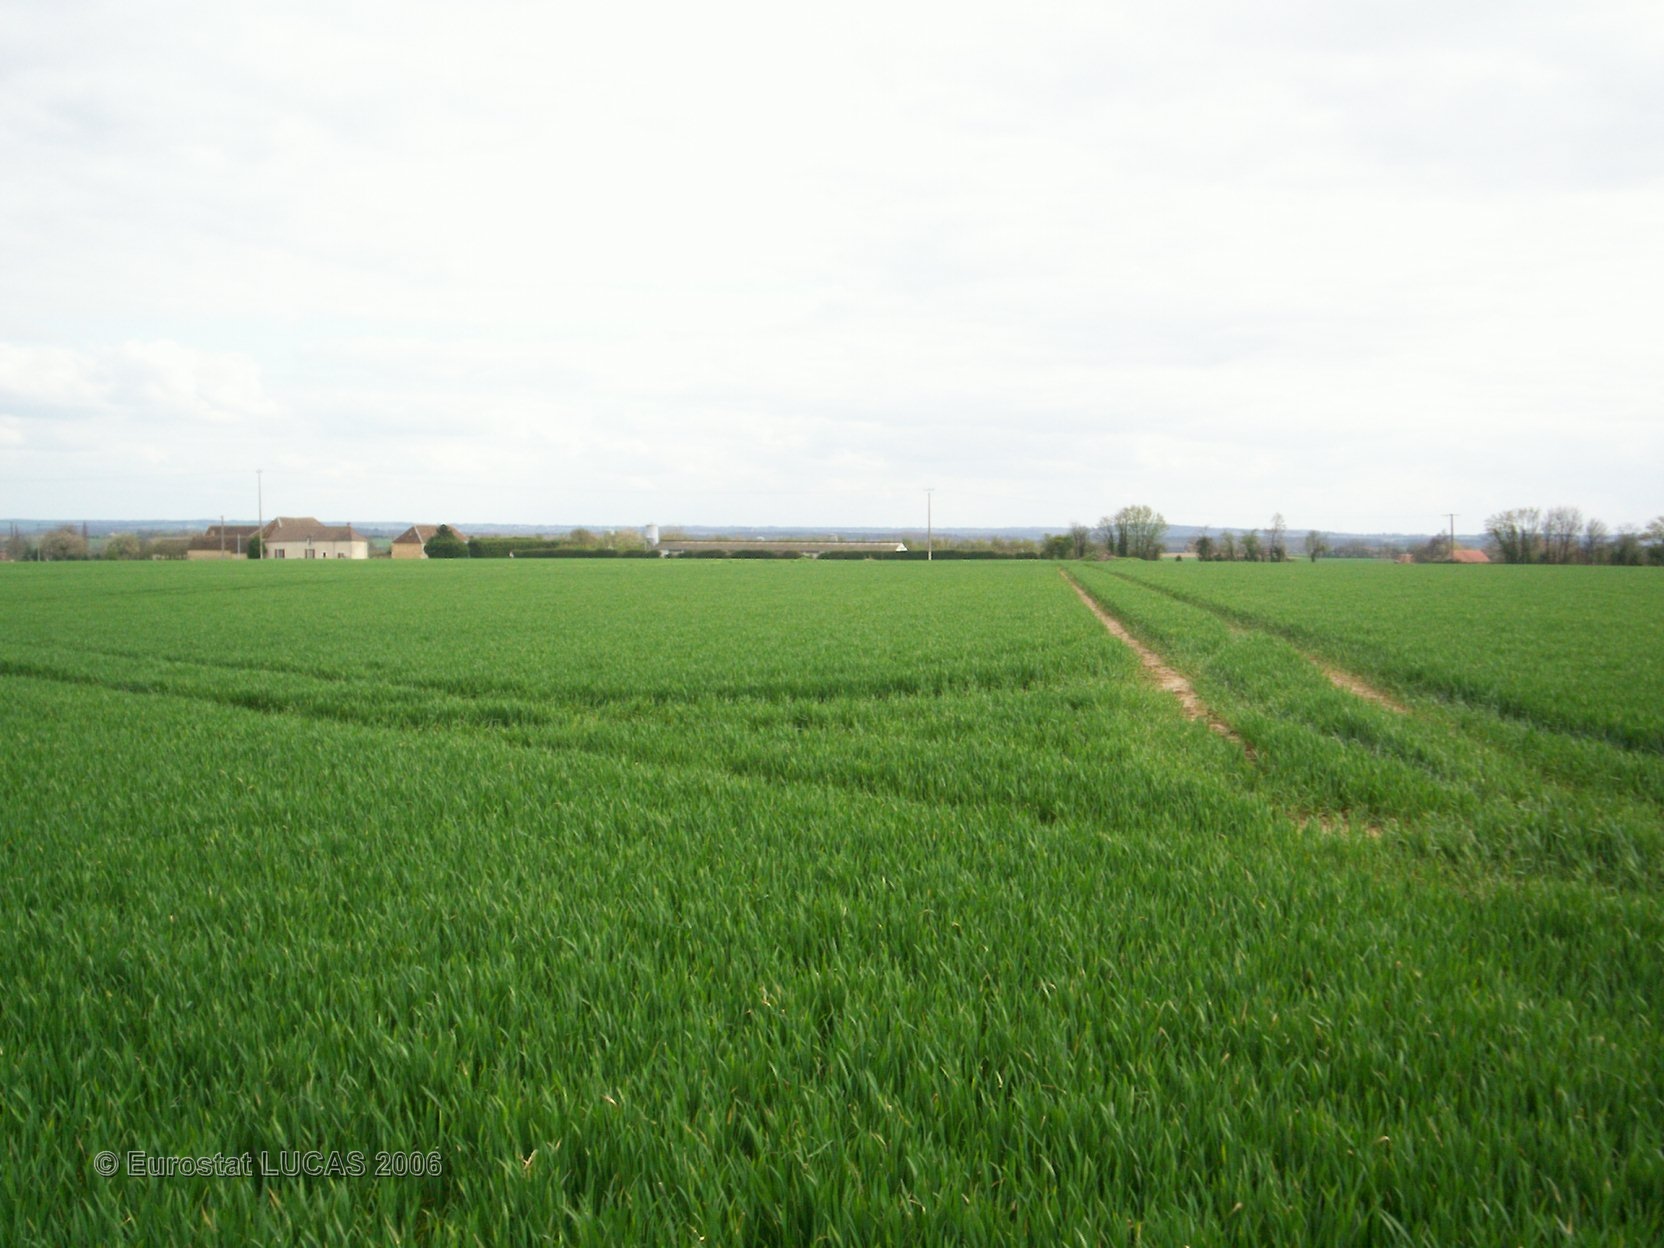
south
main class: Cropland
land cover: Common wheat
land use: Agriculture (excluding fallow land and kitchen gardens)
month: April
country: FR
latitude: 48.2696
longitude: 0.3413
